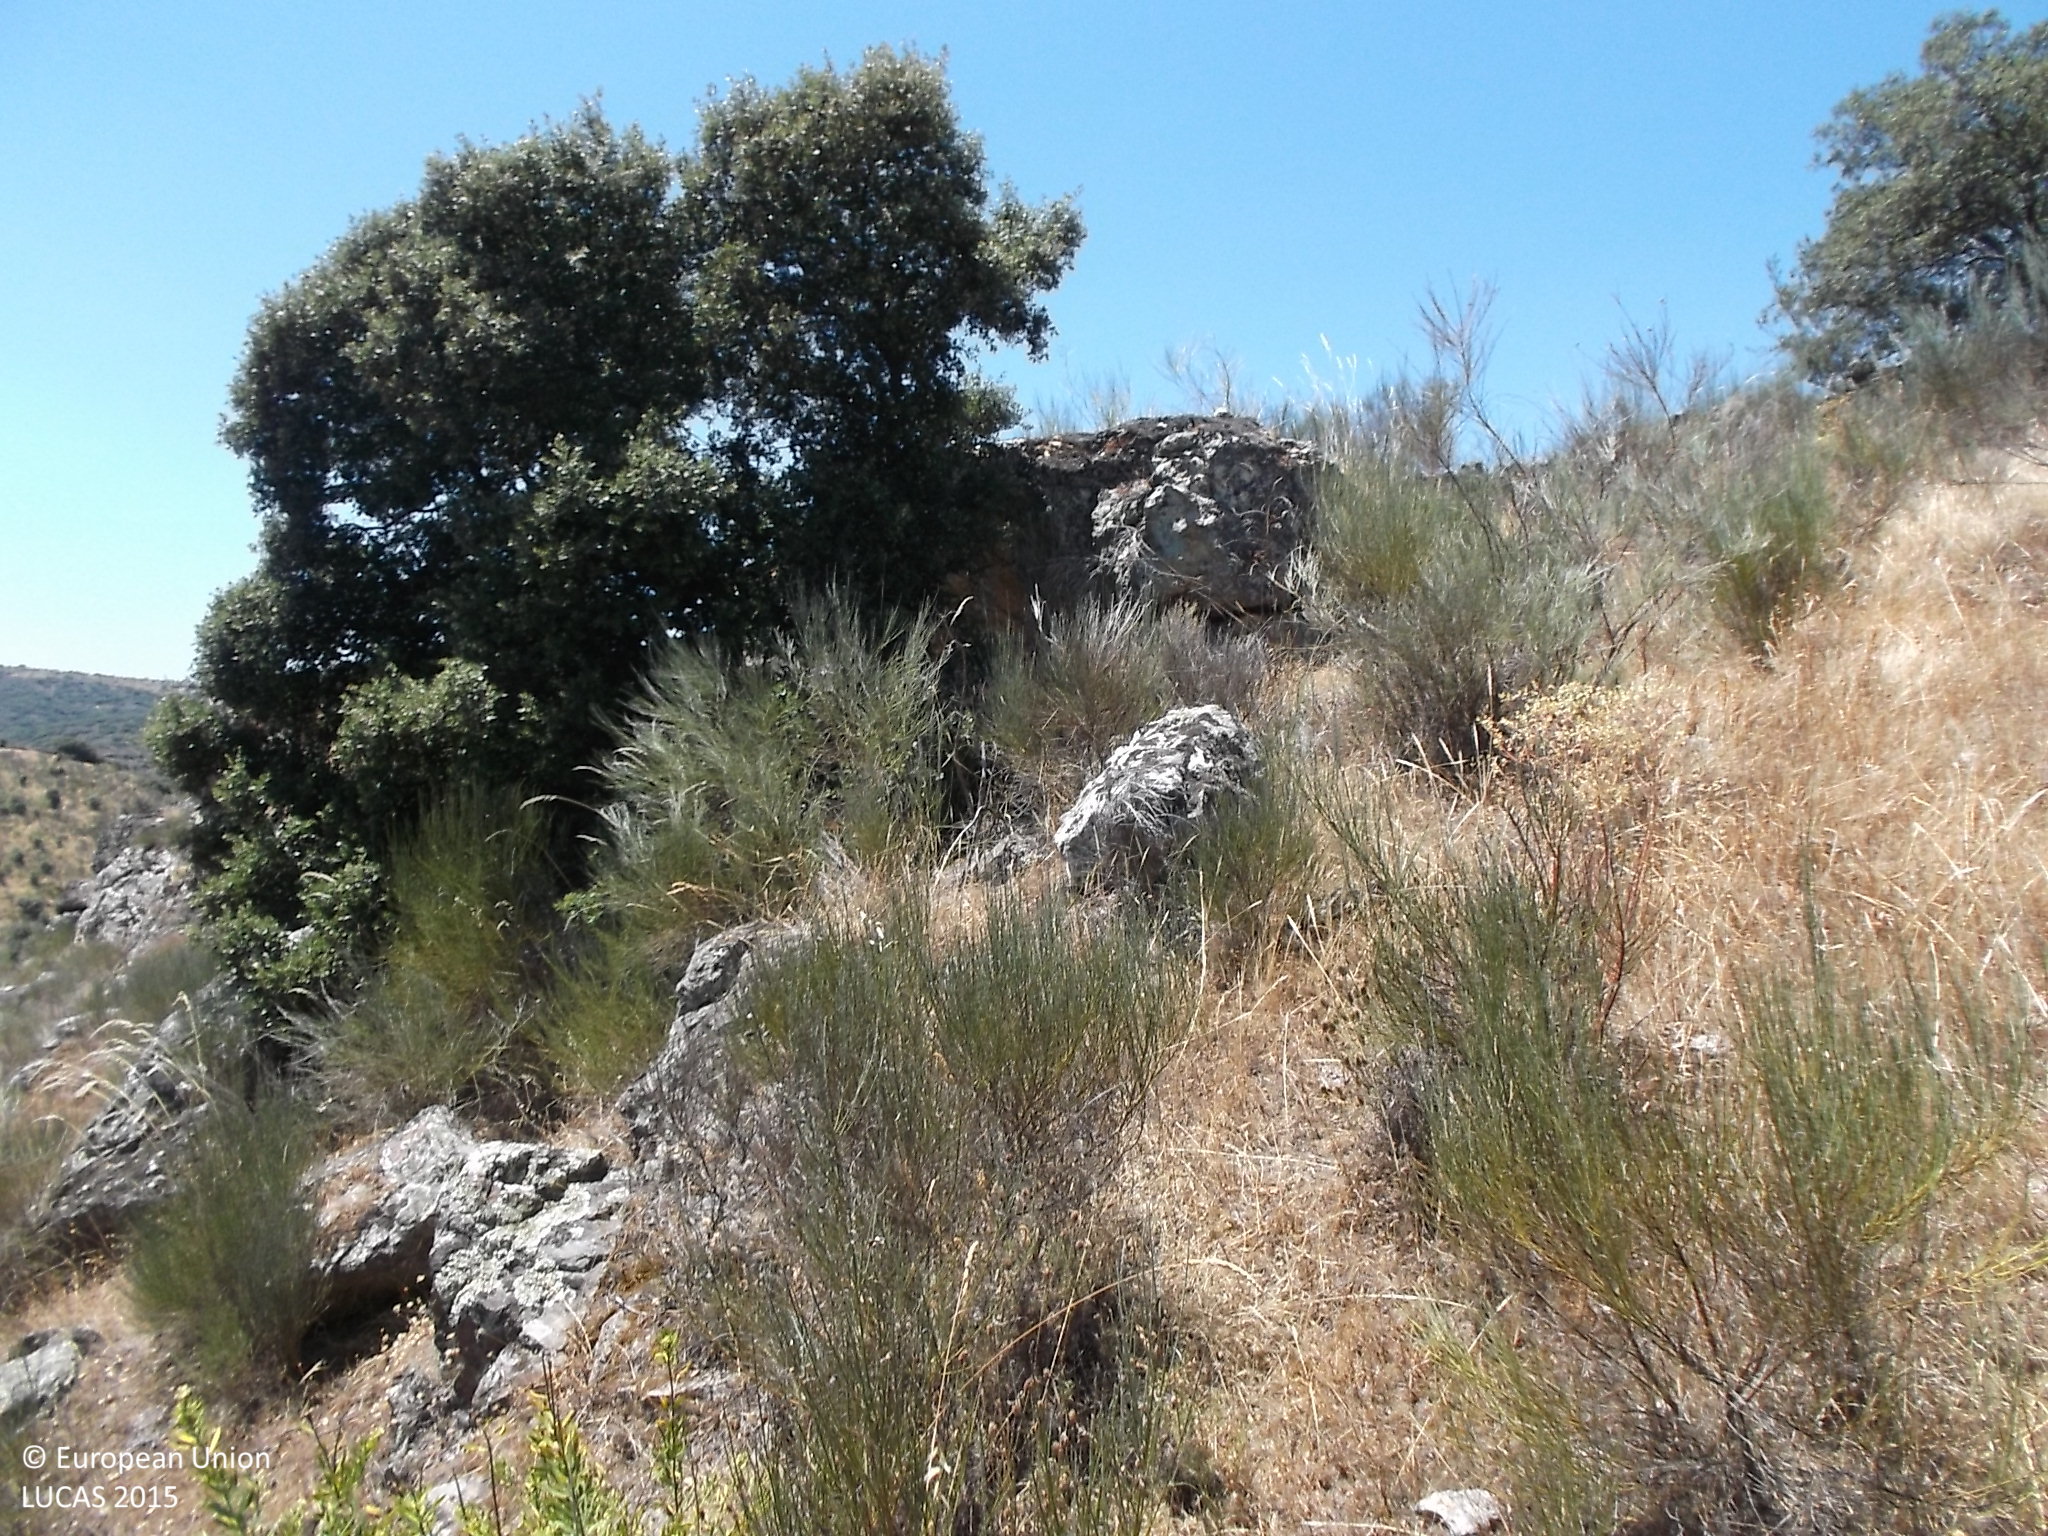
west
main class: Shrubland
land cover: Shrubland without tree cover
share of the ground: > 75 %
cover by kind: shrubs 90 %, herbaceous plants 10 %
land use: Agriculture (excluding fallow land and kitchen gardens)
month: July
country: ES
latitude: 41.0123
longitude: -6.8333
